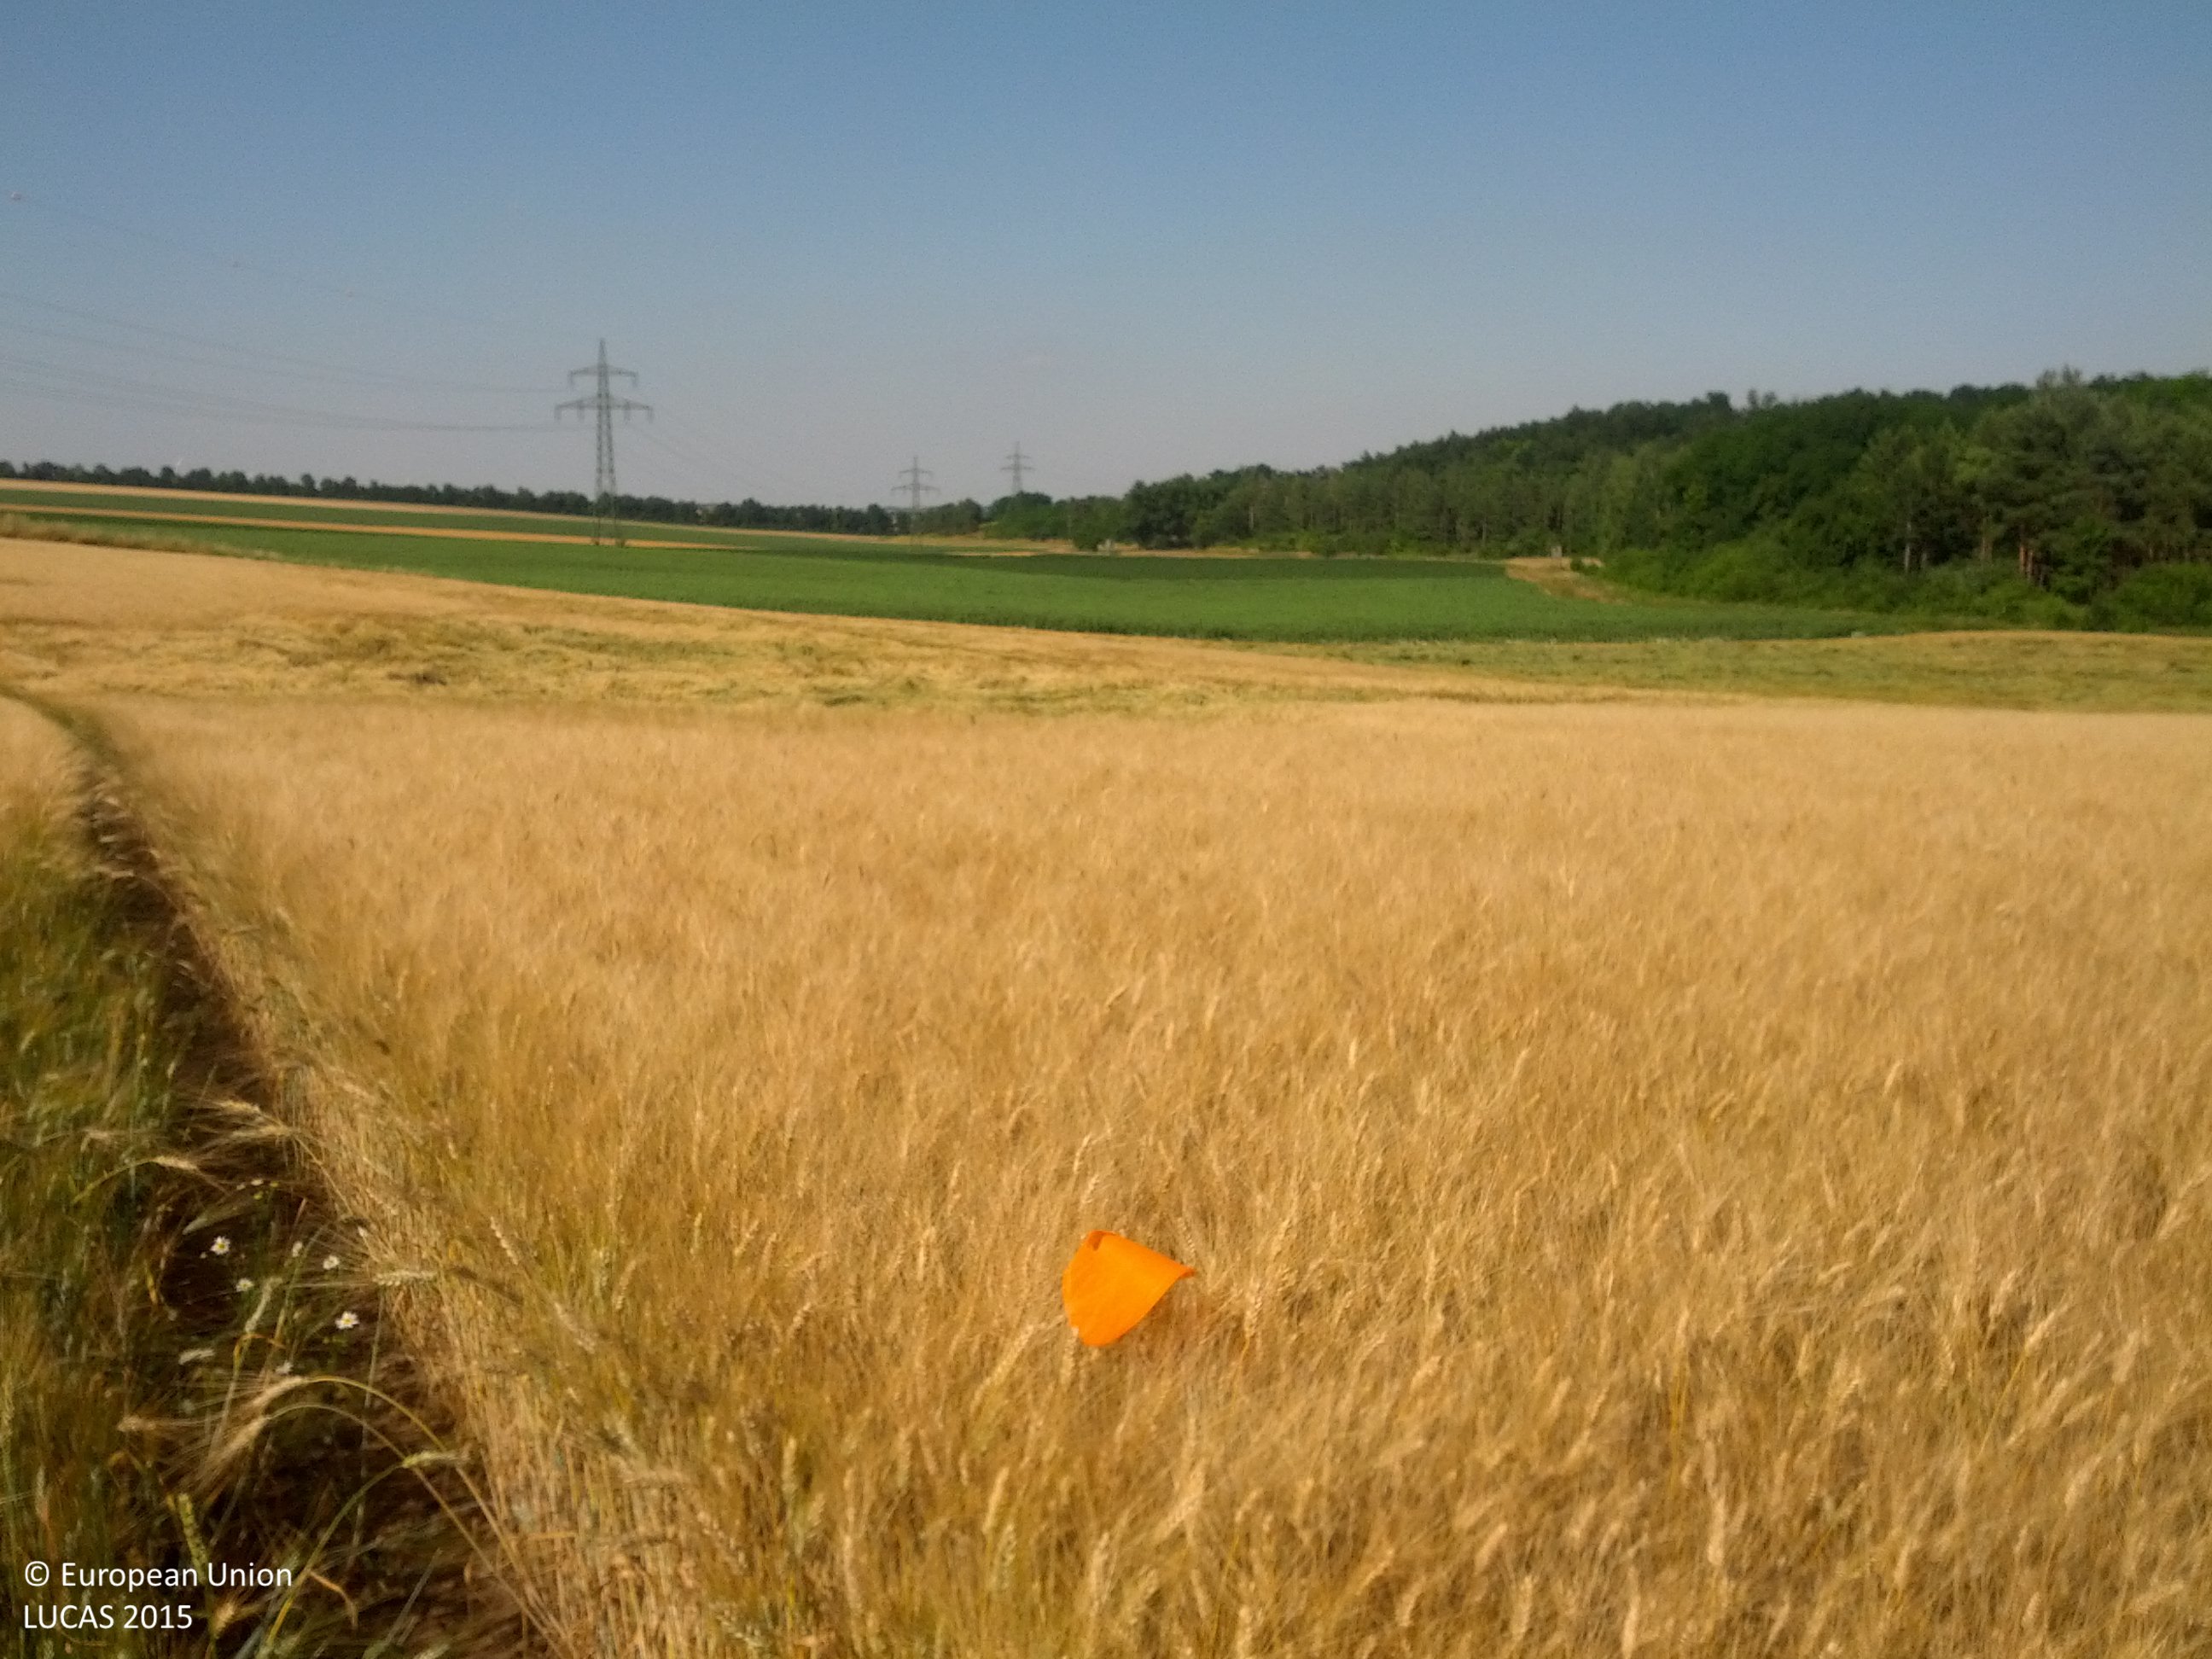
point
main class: Cropland
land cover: Barley
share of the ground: > 75 %
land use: Agriculture (excluding fallow land and kitchen gardens)
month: July
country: AT
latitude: 48.5474
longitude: 16.6308
